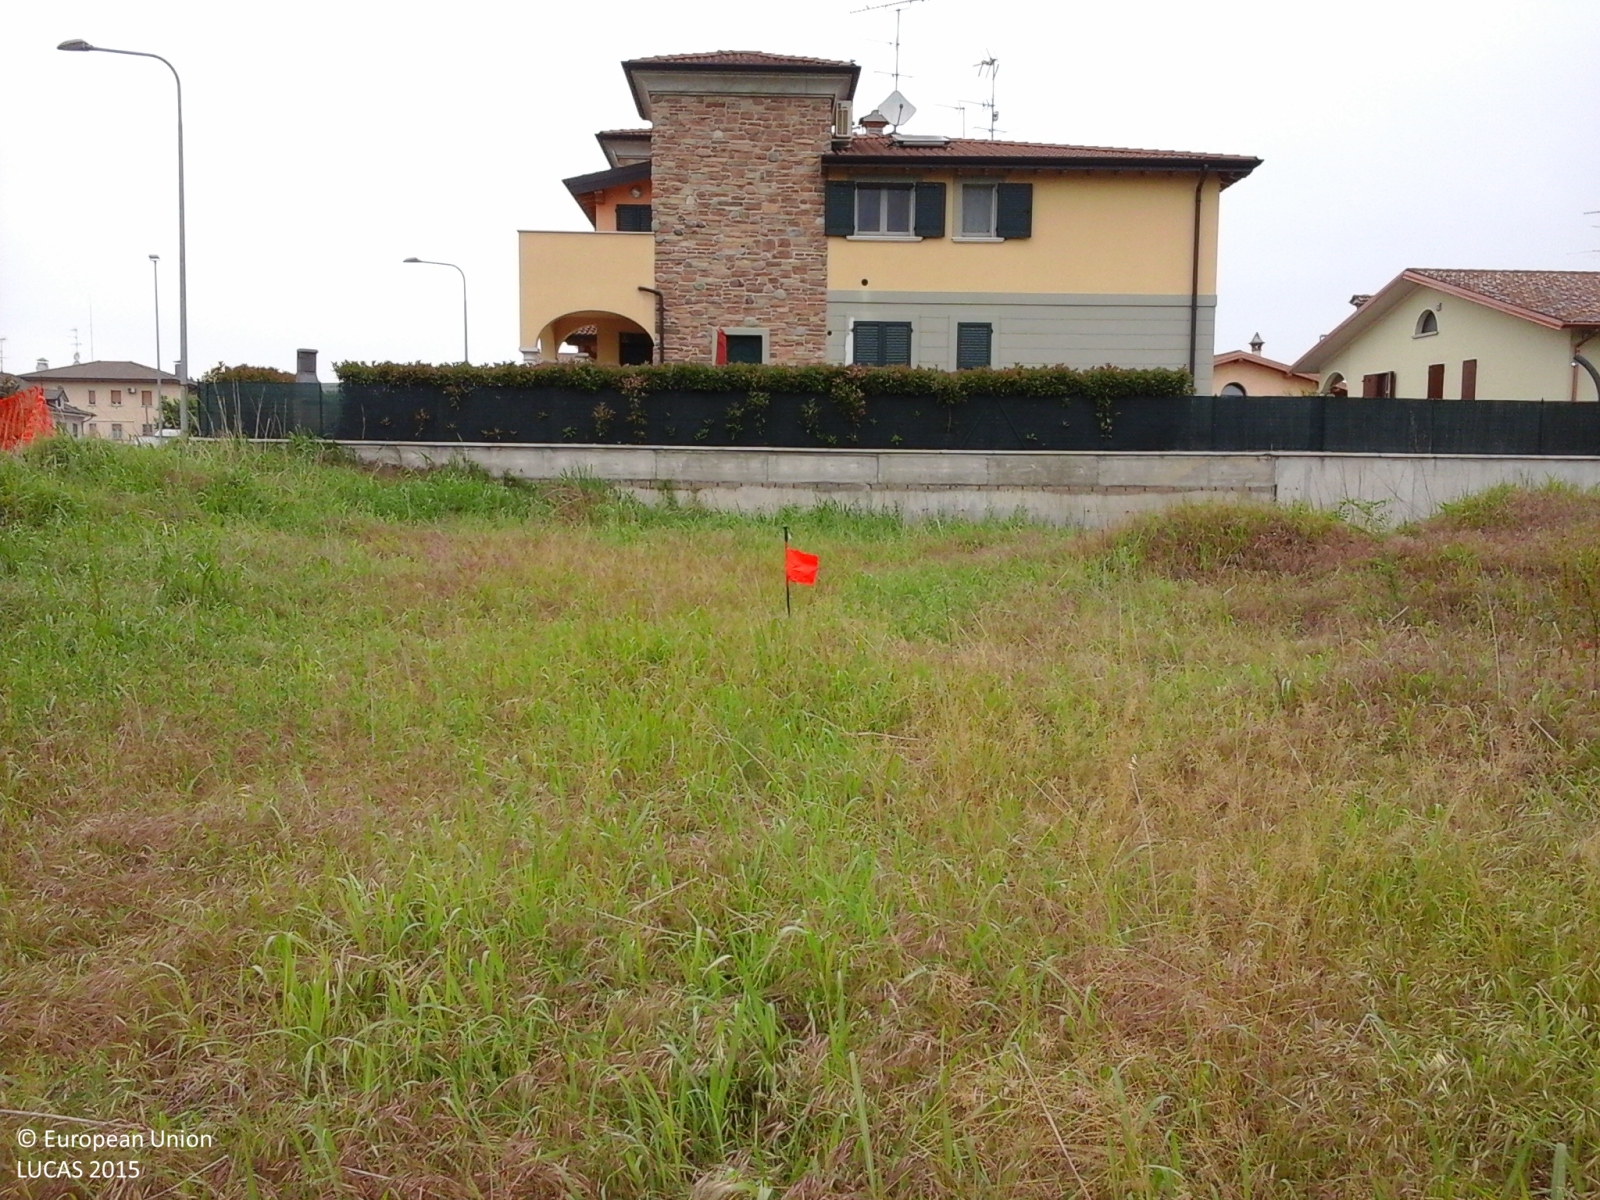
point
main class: Grassland
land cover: Spontaneously vegetated surfaces
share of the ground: > 75 %
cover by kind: herbaceous plants 100 %
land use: Abandoned areas
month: May
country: IT
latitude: 45.2517
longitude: 10.2925
